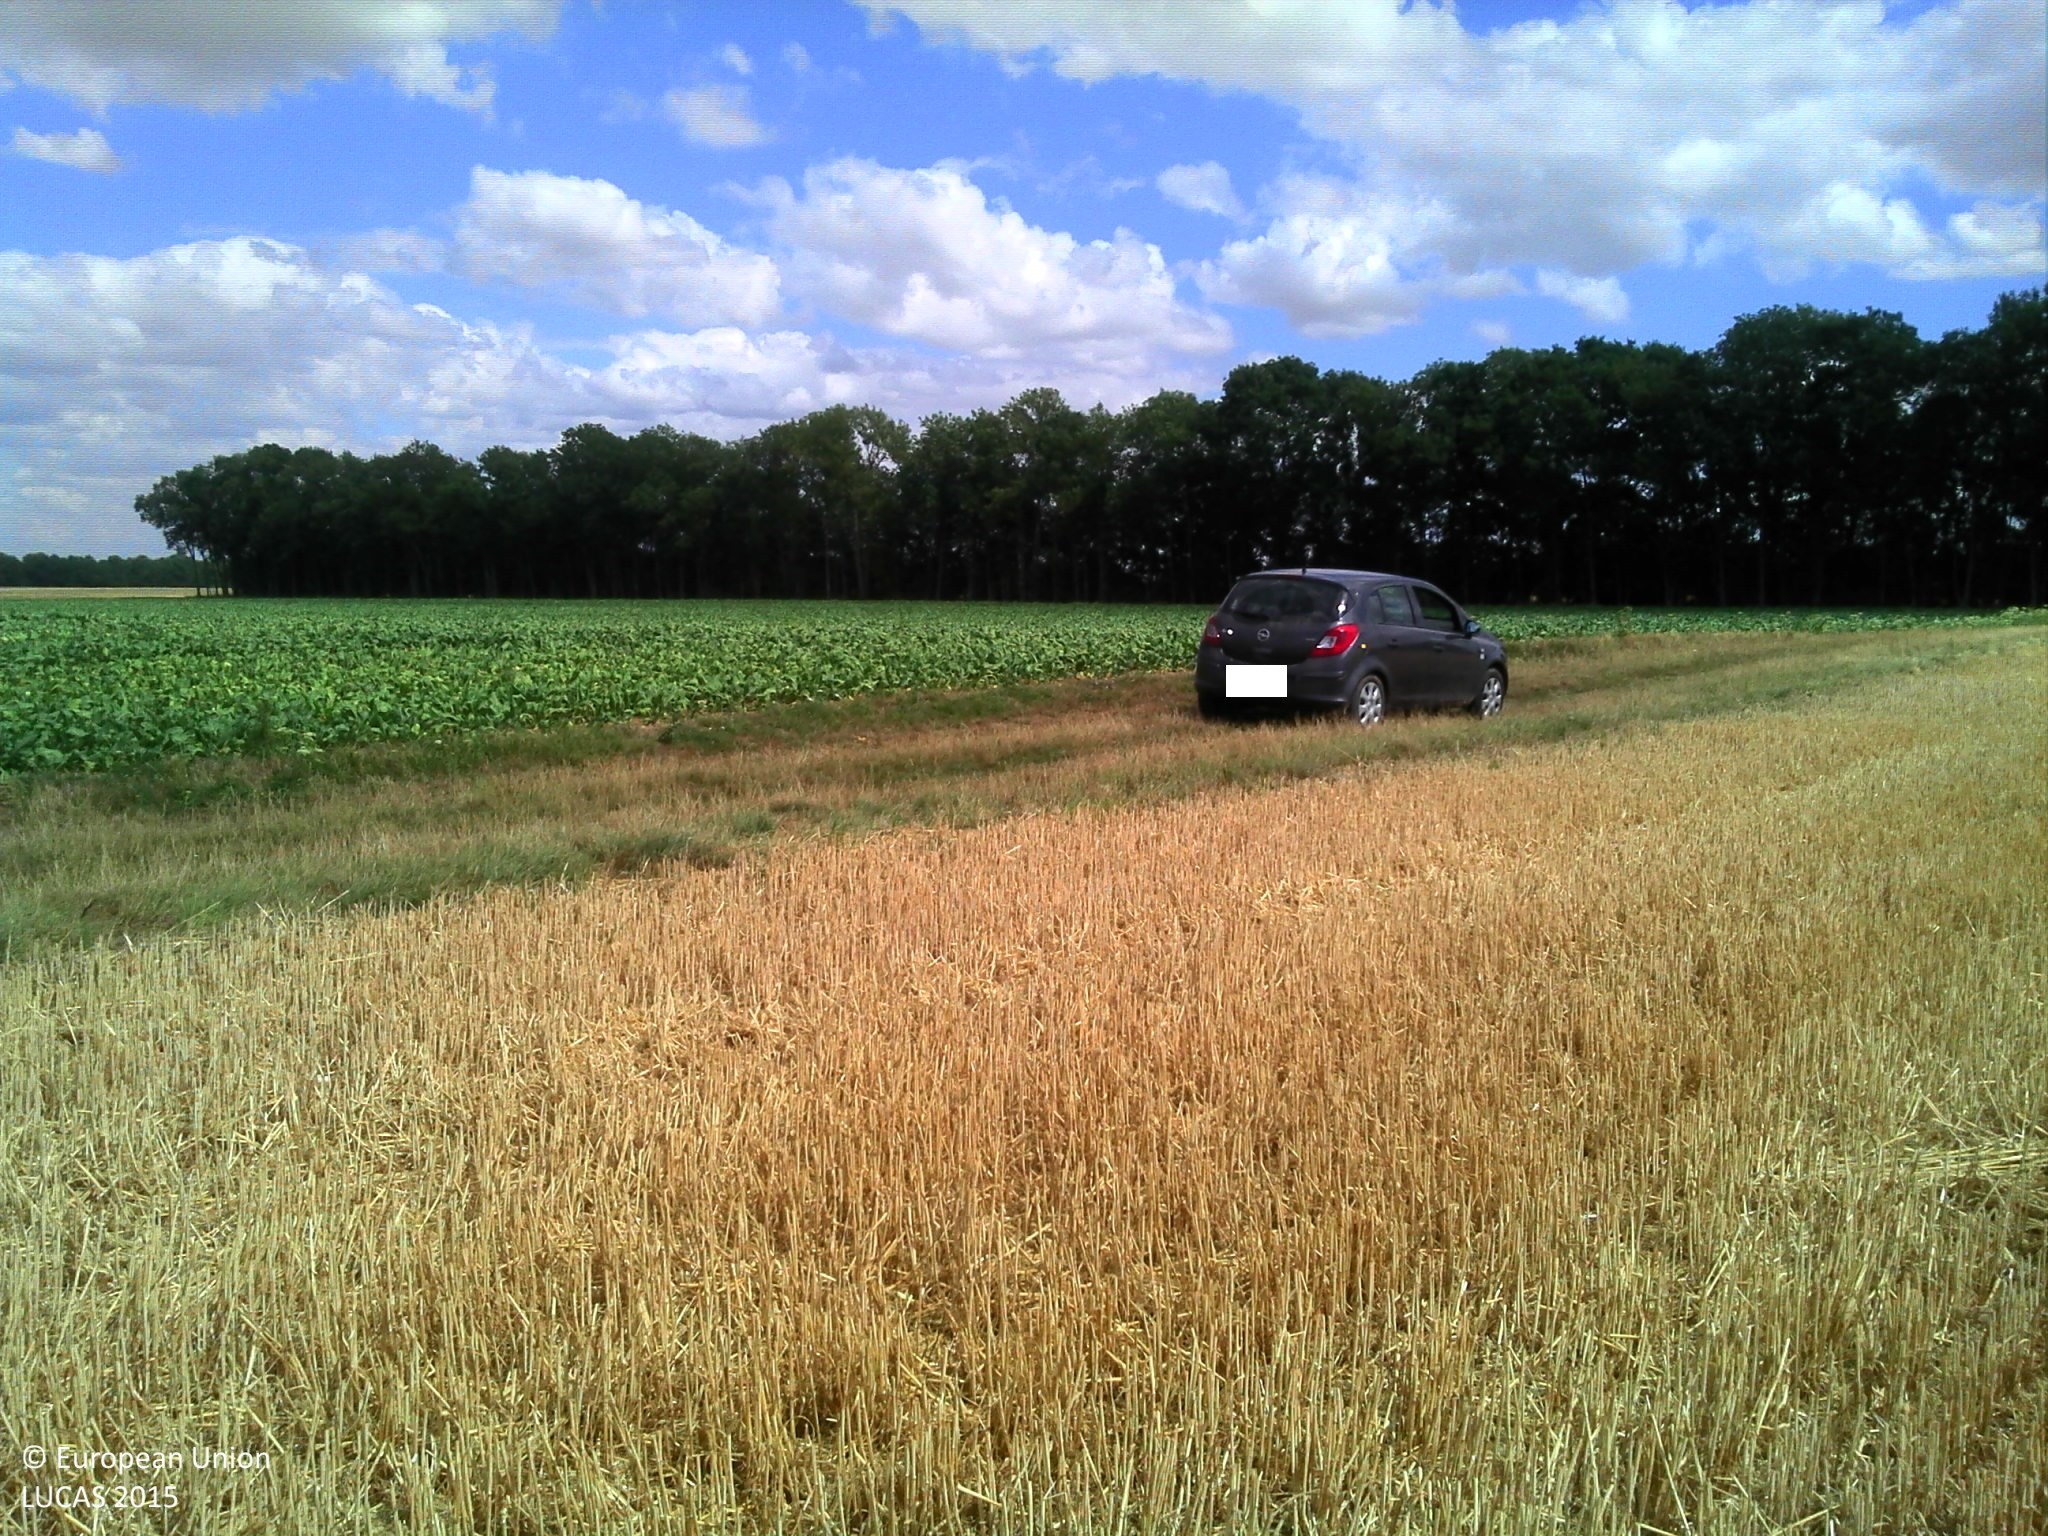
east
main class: Cropland
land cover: Common wheat
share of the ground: 10 - 25 %
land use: Agriculture (excluding fallow land and kitchen gardens)
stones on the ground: 10 - 25 %
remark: Harvested field
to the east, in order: Common wheat; Grass margins; Tracks; Grass margins; Sugar beet; Broadleaved woodland; Other fibre and oleaginous crops
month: August
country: FR
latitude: 48.6190
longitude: 3.3597
